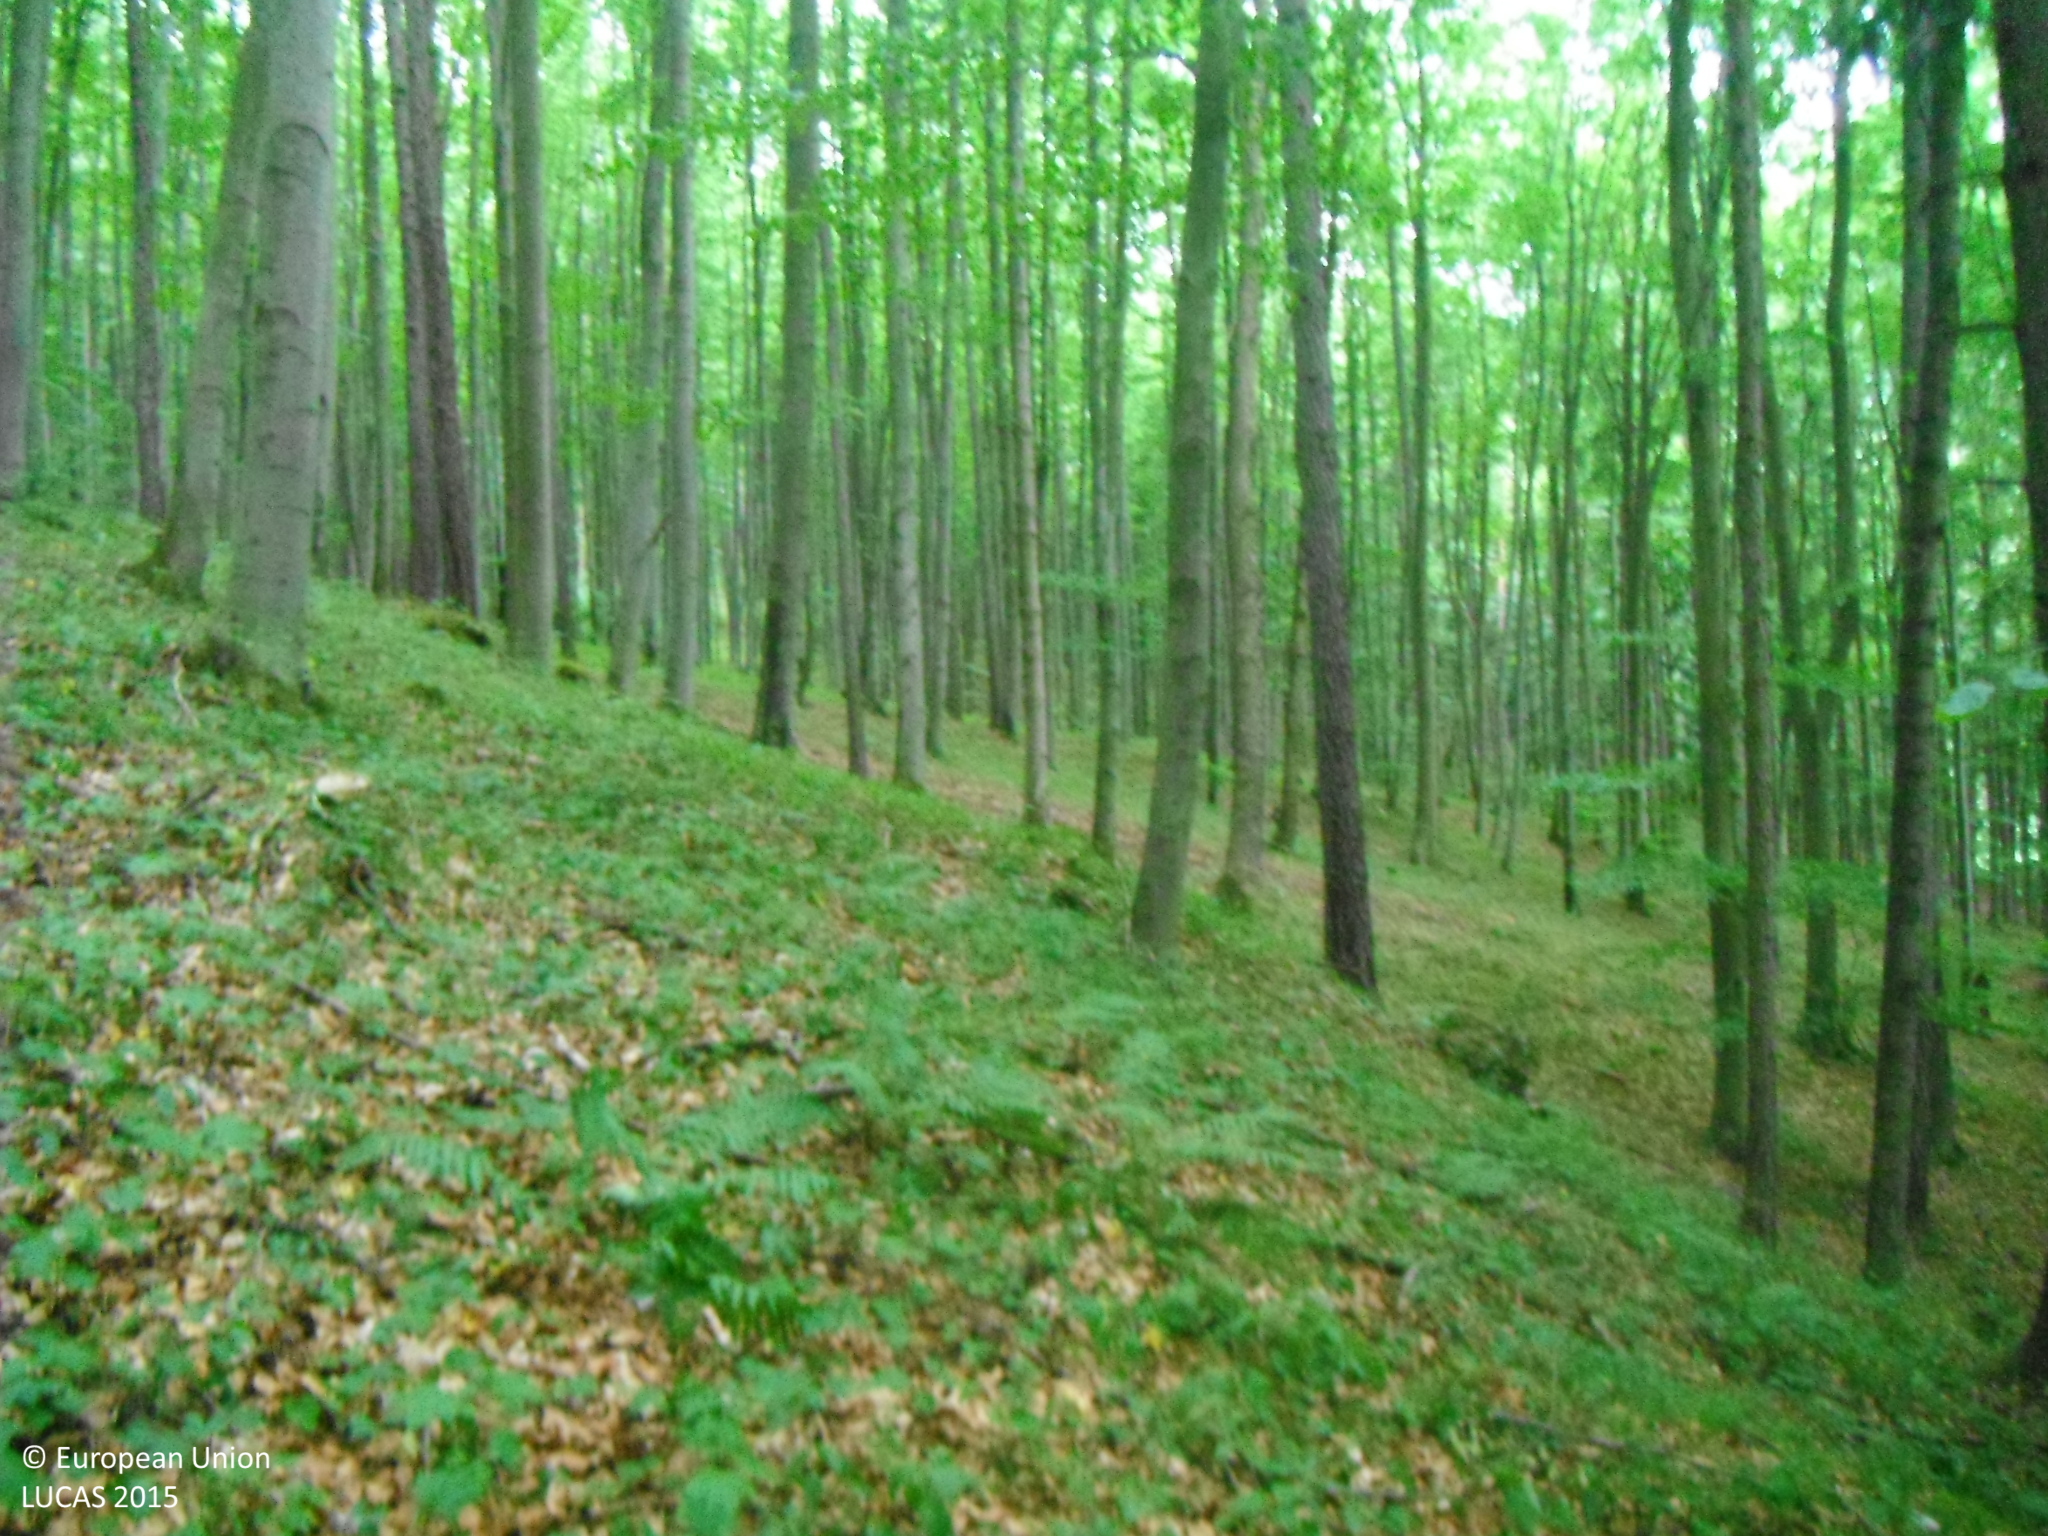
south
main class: Woodland
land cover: Pine dominated mixed woodland
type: hemiboreal forest and nemoral coniferous forest and mixed broadleaved-coniferous forest
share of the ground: > 75 %
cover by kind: coniferous forest trees 45 %, broadleaved forest trees 45 %, herbaceous plants 5 %, unconsolidated bare surface 5 %
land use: Forestry
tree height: > 5 m
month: July
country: SK
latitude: 49.0116
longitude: 18.5633
